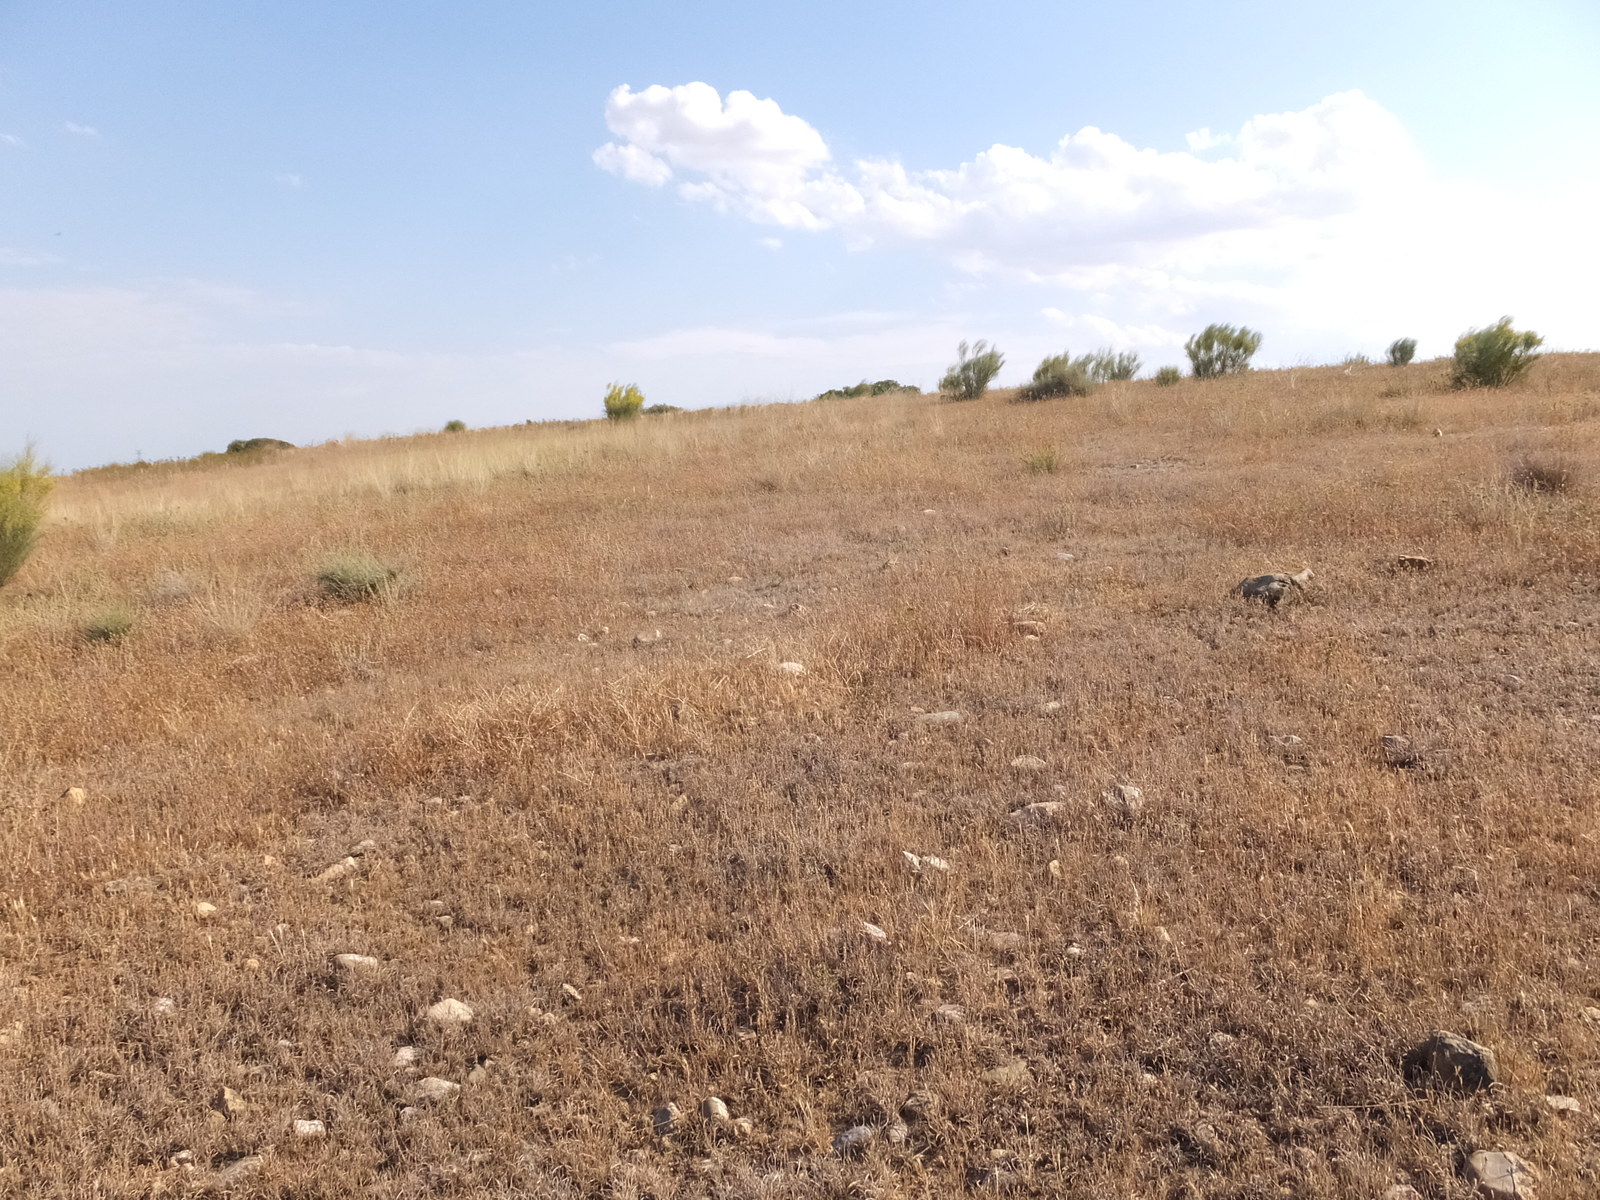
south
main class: Grassland
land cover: Grassland without tree/shrub cover
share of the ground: 50 - 75 %
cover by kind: herbaceous plants 70 %, consolidated bare surface 25 %, shrubs 5 %
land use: Abandoned areas
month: June
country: ES
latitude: 41.2982
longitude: -0.2249
